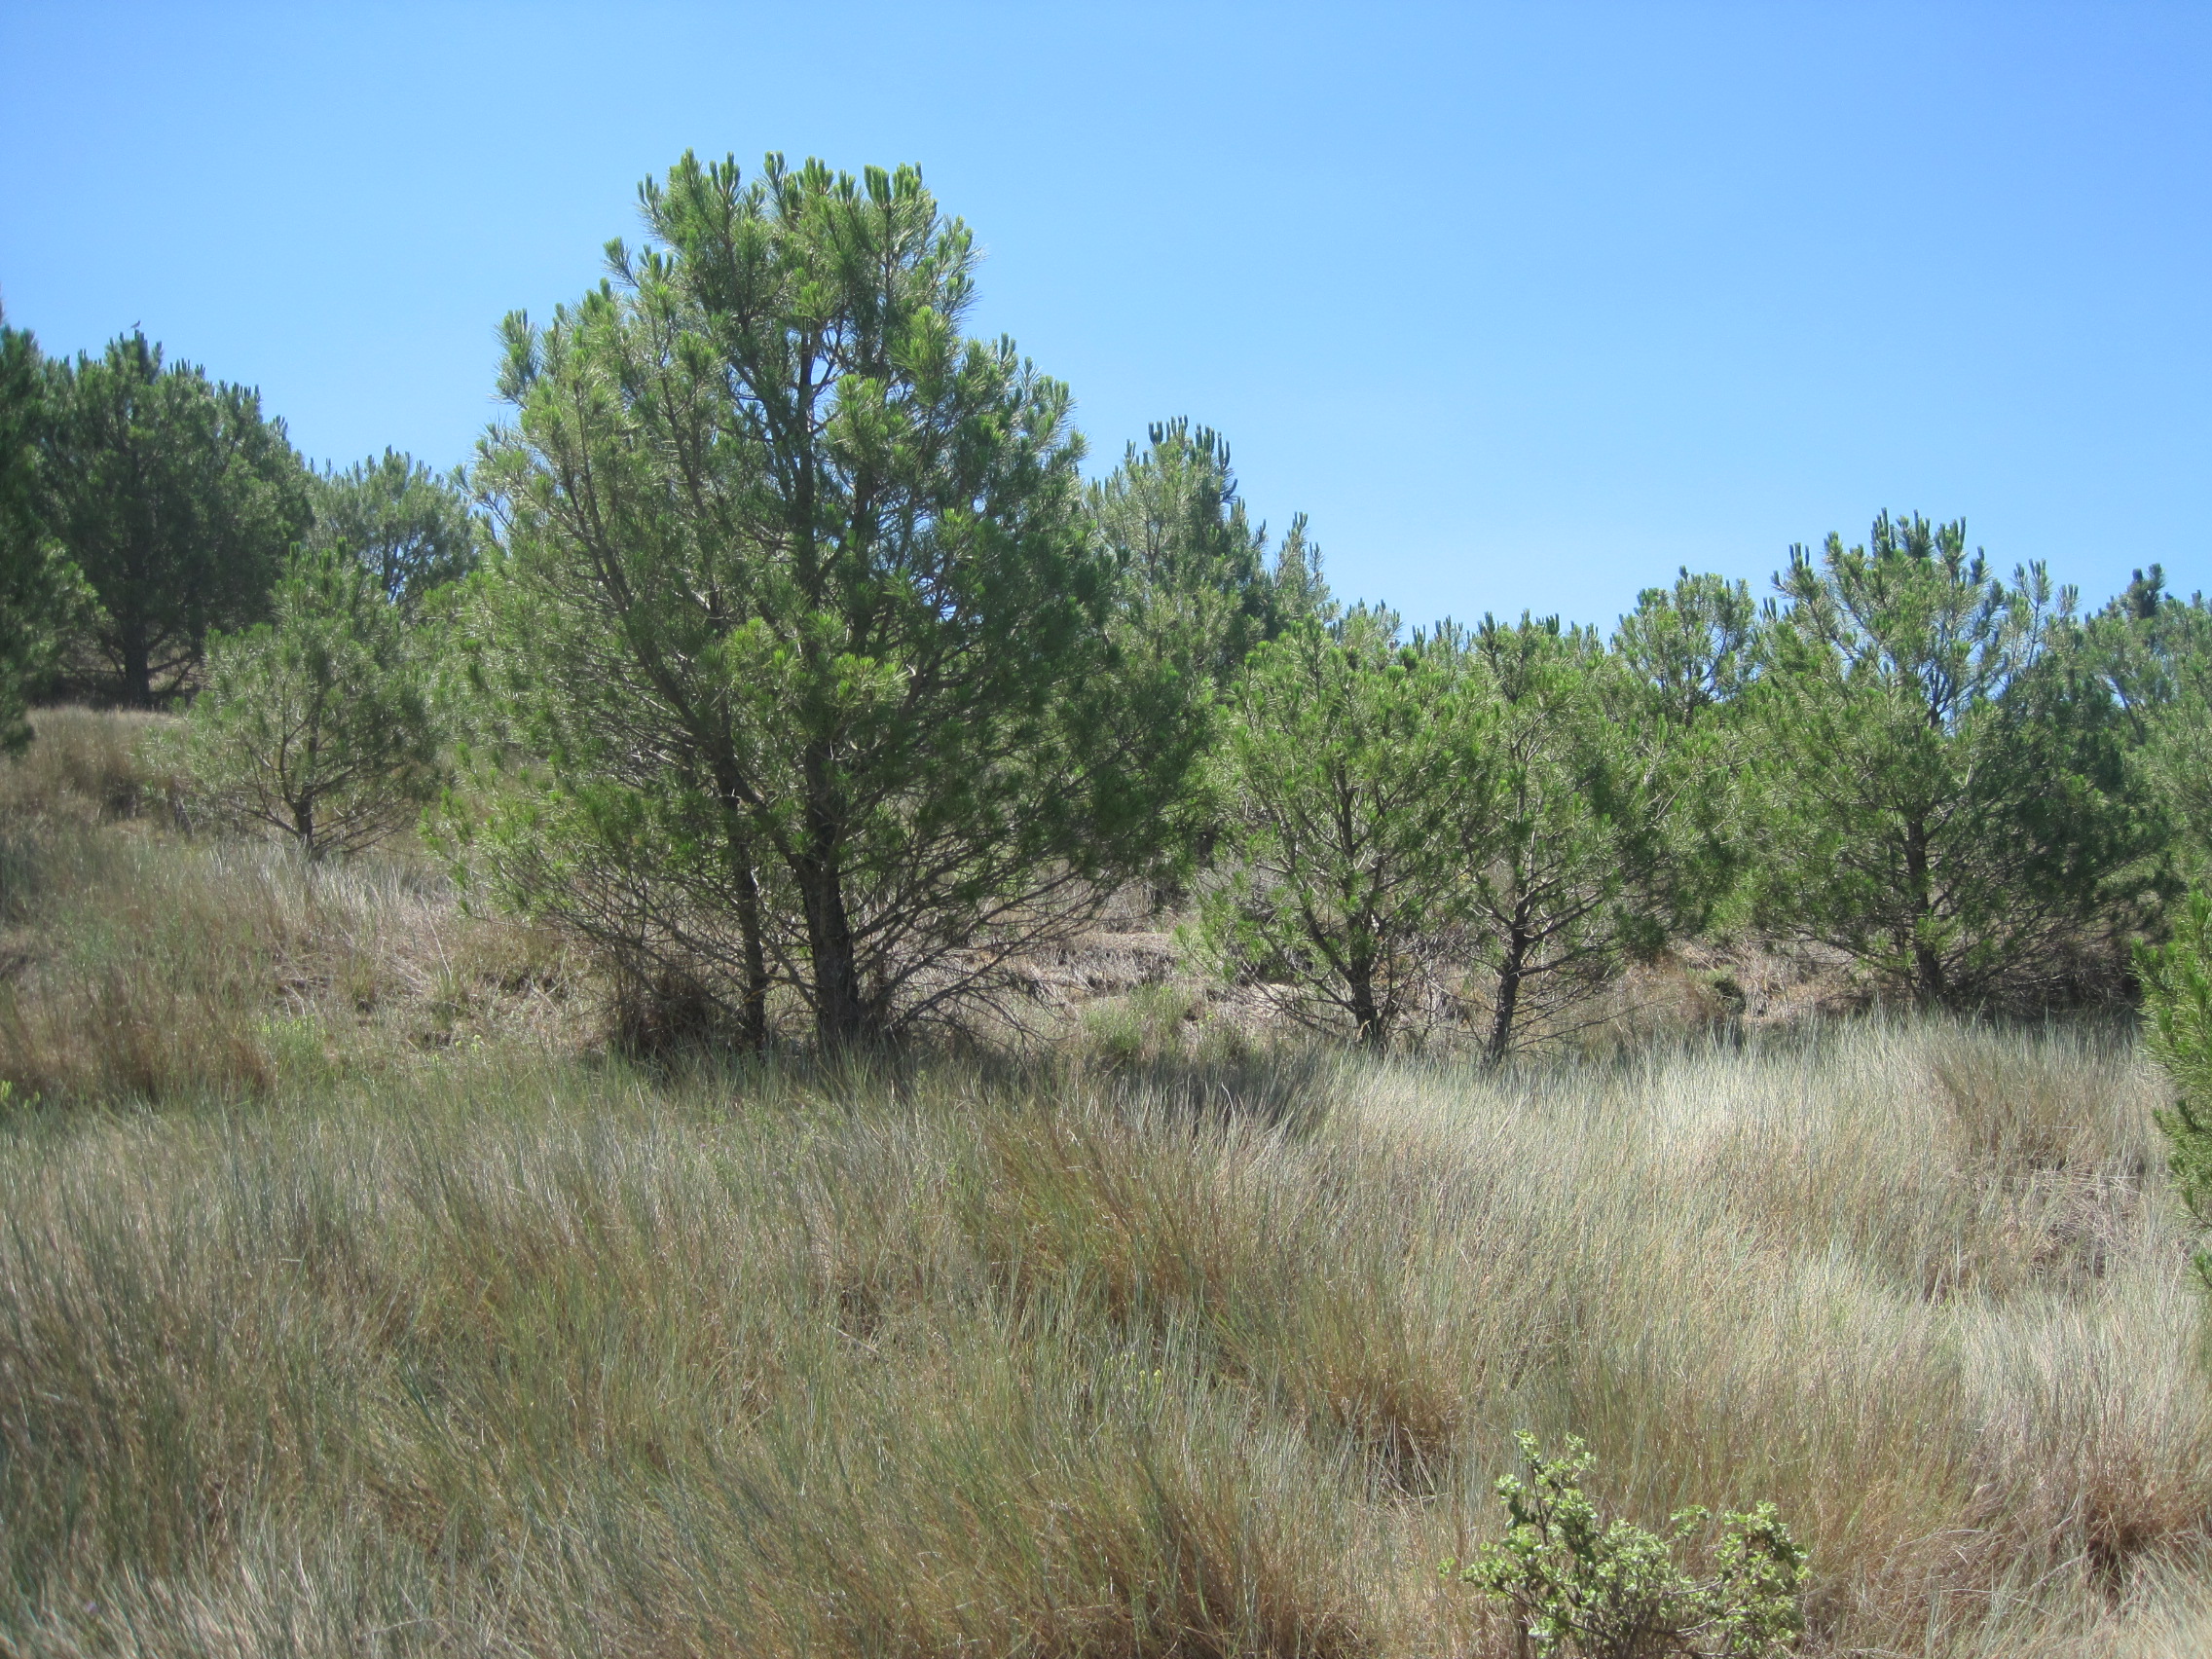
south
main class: Woodland
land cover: Pine dominated coniferous woodland
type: coniferous forest of the mediterranean region
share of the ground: 25 - 50 %
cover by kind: herbaceous plants 60 %, coniferous forest trees 40 %
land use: Semi-natural and natural areas not in use
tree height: > 5 m
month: July
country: ES
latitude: 41.9621
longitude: -4.6837
